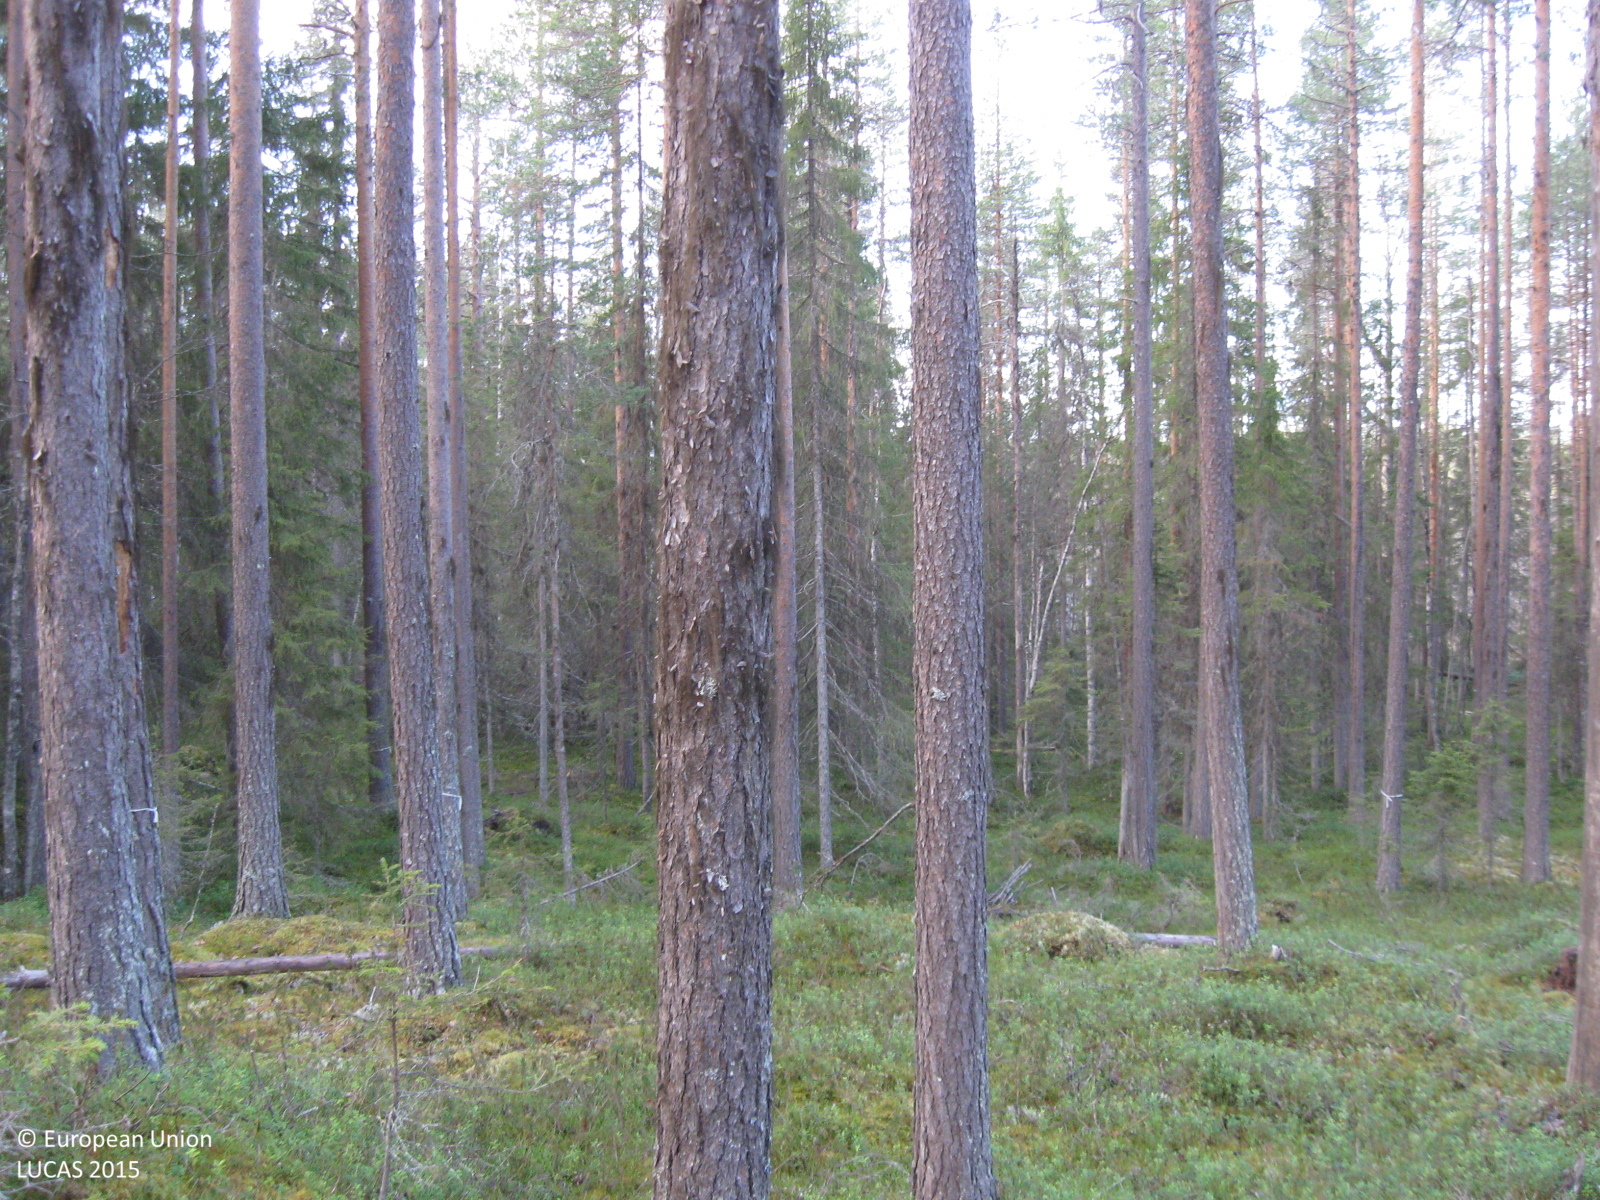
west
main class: Woodland
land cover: Pine dominated coniferous woodland
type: boreal forest
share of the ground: 50 - 75 %
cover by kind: coniferous forest trees 65 %, shrubs 10 %, herbaceous plants 10 %, lichens and mosses 10 %, unconsolidated bare surface 5 %
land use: Forestry
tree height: > 5 m
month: November
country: SE
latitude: 66.1406
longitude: 20.9296
